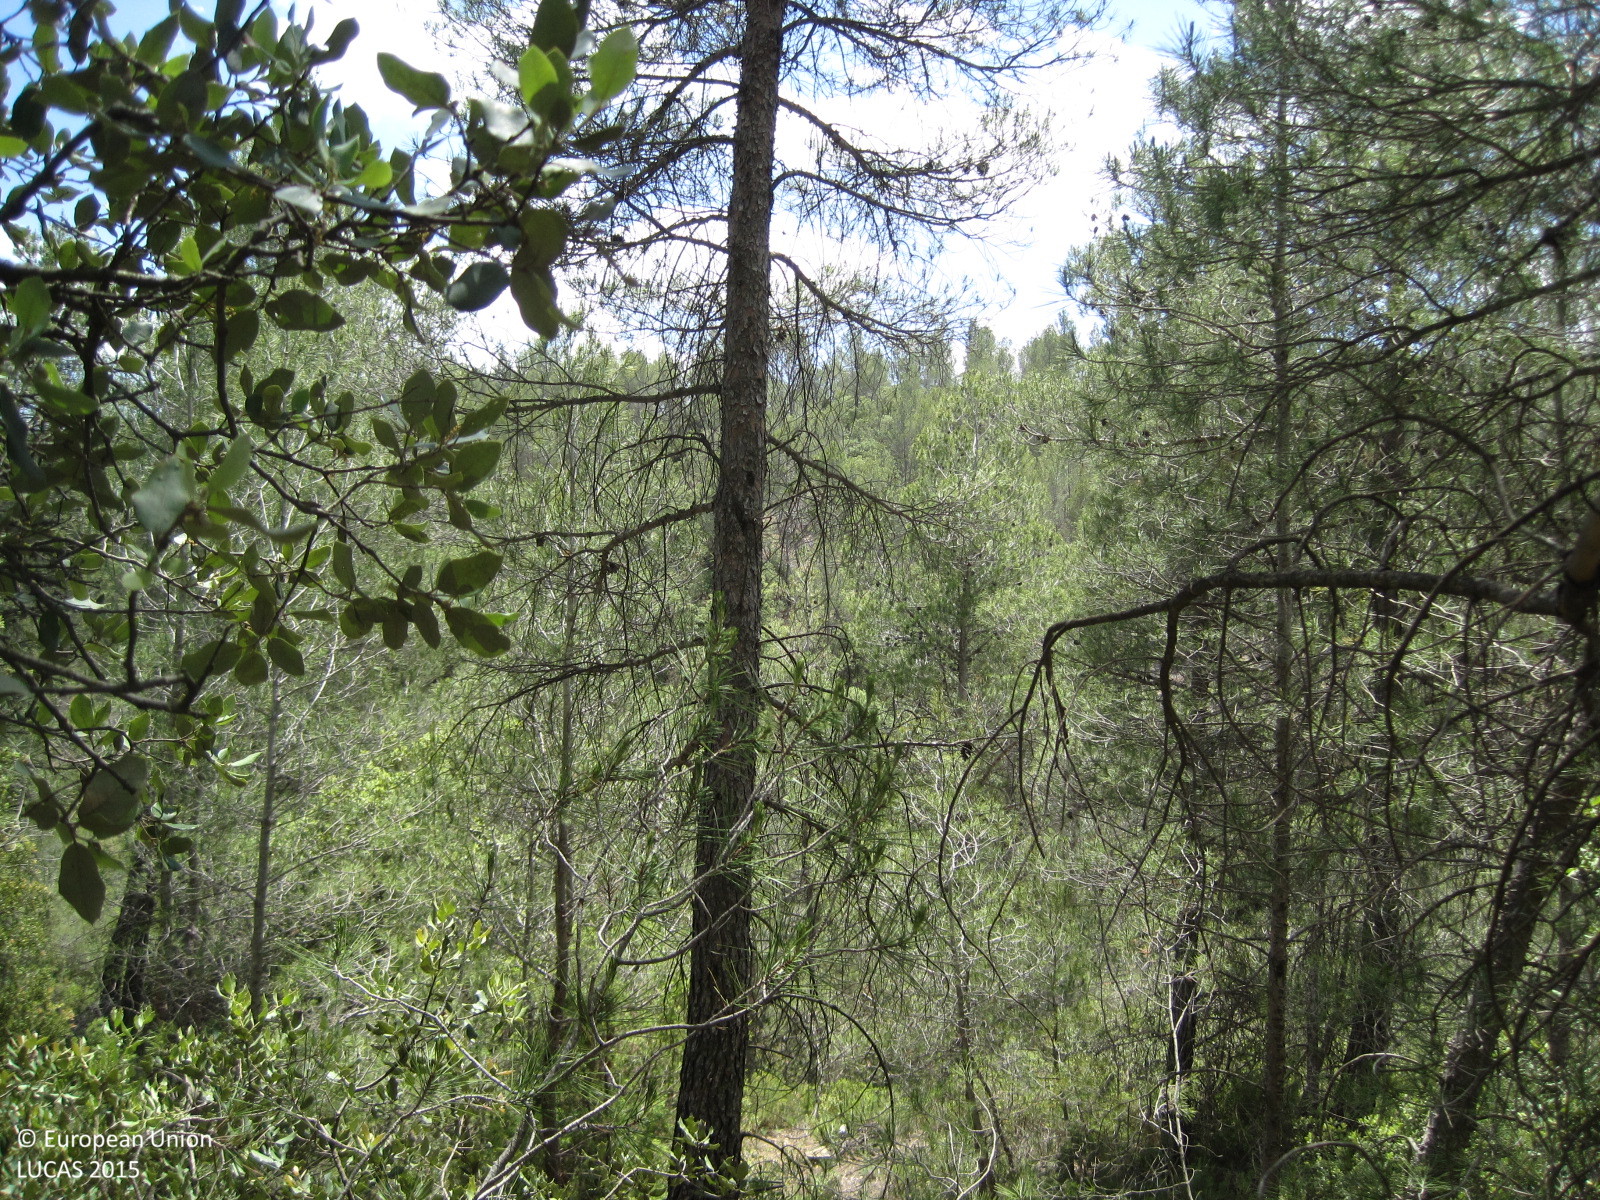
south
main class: Woodland
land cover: Pine dominated coniferous woodland
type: coniferous forest of the mediterranean region
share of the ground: 50 - 75 %
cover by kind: coniferous forest trees 60 %, shrubs 20 %, broadleaved forest trees 15 %, herbaceous plants 5 %
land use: Forestry
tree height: > 5 m
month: May
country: ES
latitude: 39.5988
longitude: -1.1006
